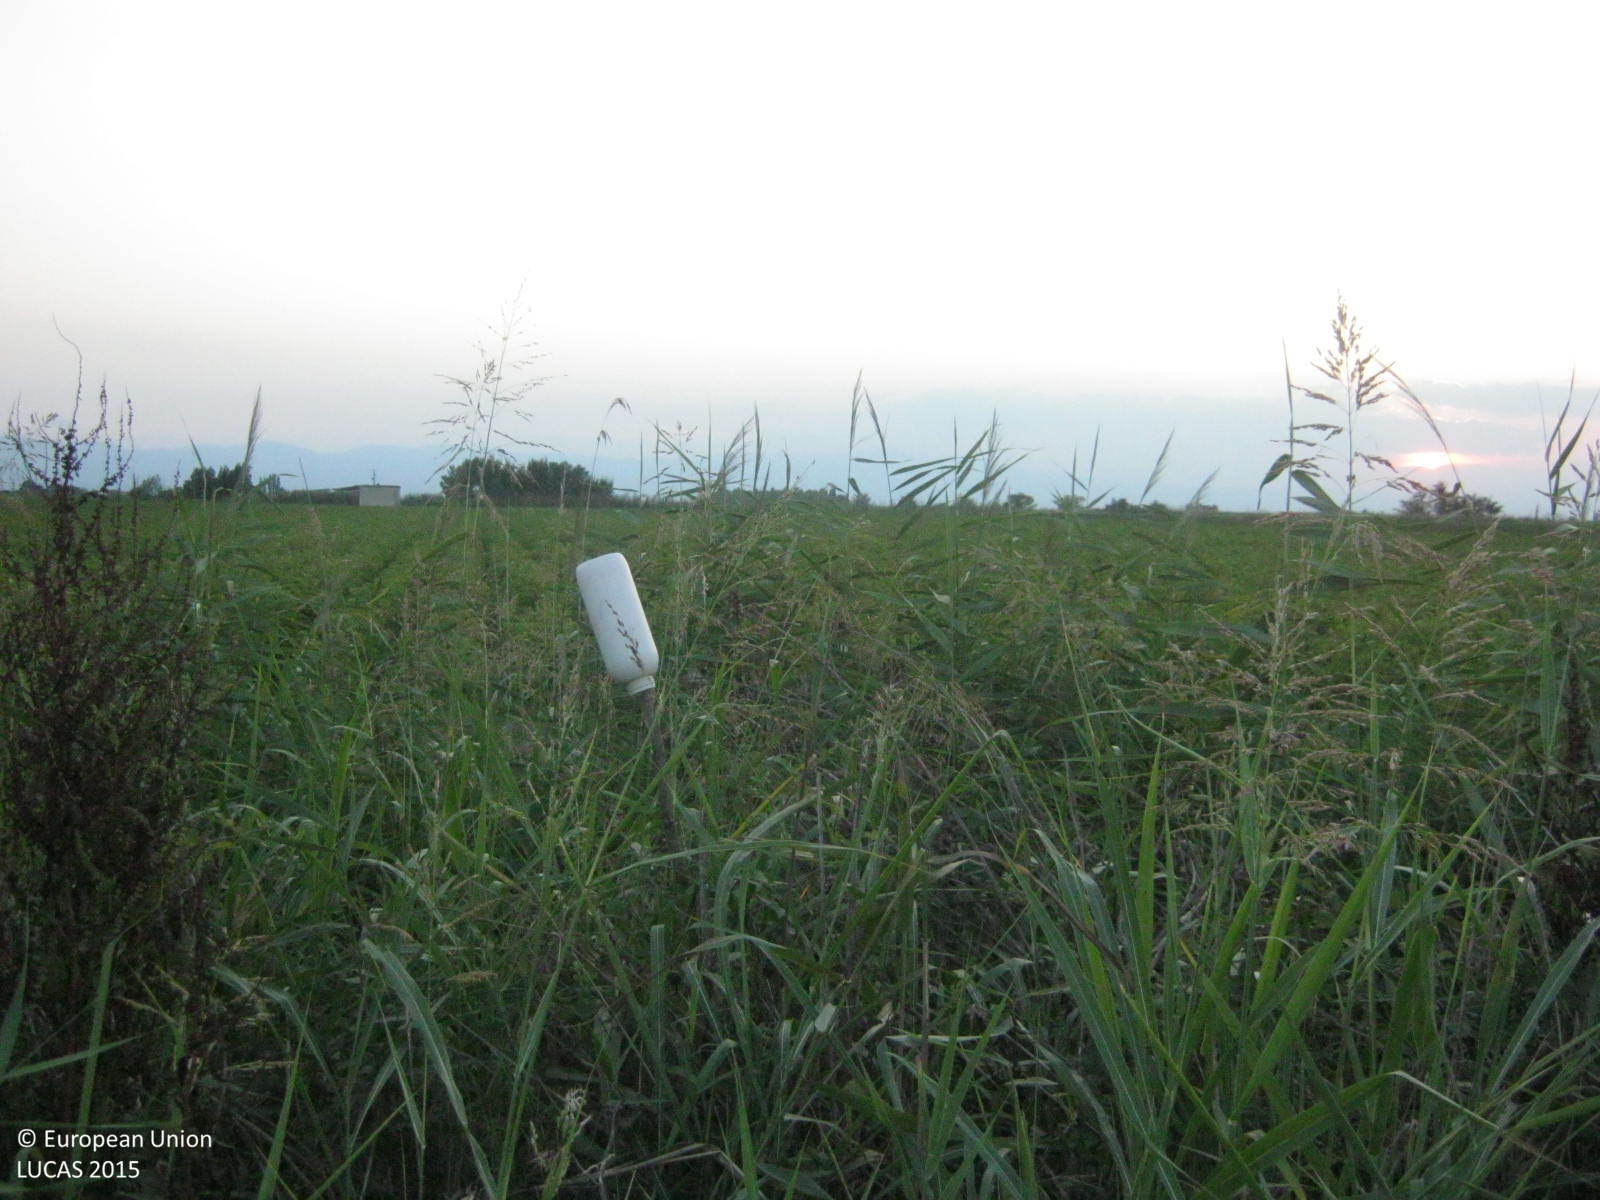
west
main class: Cropland
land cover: Cotton
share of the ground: > 75 %
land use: Agriculture (excluding fallow land and kitchen gardens)
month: August
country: GR
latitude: 40.6077
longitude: 22.5659
